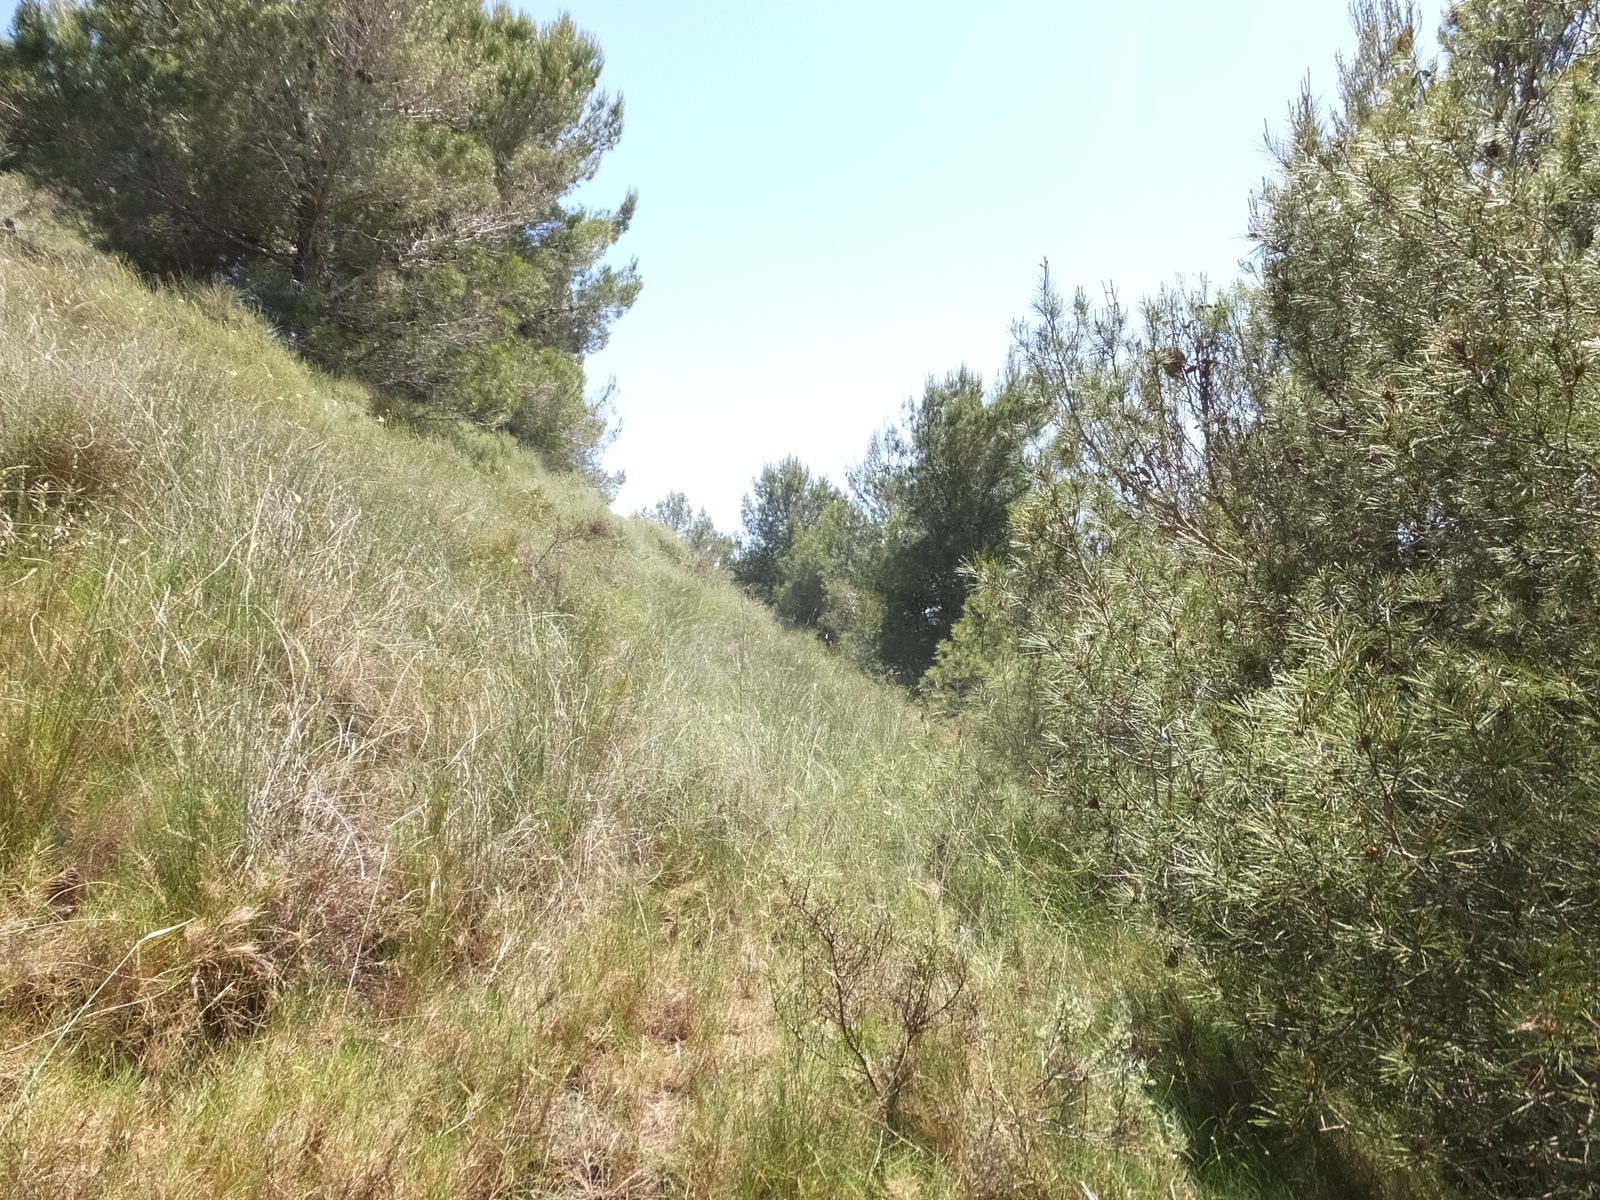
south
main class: Woodland
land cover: Pine dominated coniferous woodland
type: coniferous forest of the mediterranean region
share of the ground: > 75 %
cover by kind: coniferous forest trees 70 %, shrubs 15 %, herbaceous plants 15 %
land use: Semi-natural and natural areas not in use
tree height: > 5 m
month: May
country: ES
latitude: 41.7983
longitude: -0.1392
